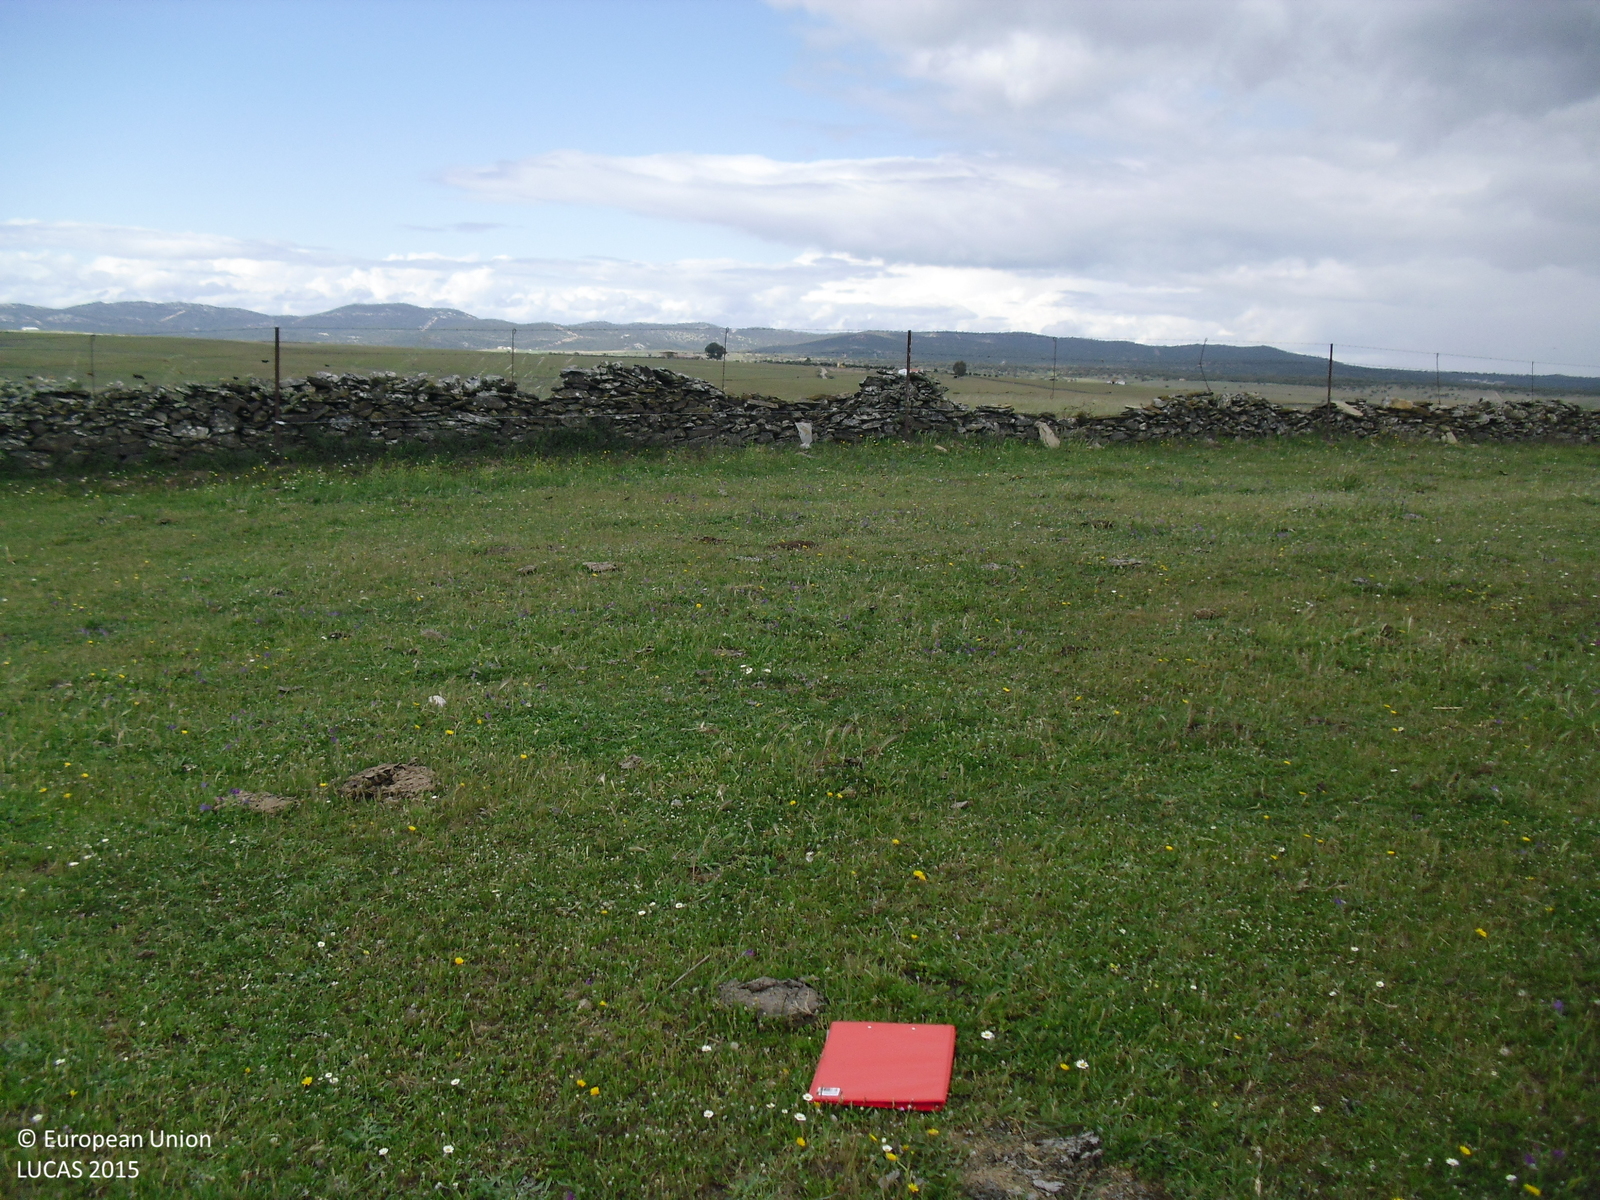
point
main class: Grassland
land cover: Grassland without tree/shrub cover
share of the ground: > 75 %
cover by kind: herbaceous plants 100 %
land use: Agriculture (excluding fallow land and kitchen gardens)
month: April
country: ES
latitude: 39.3920
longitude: -7.1395
